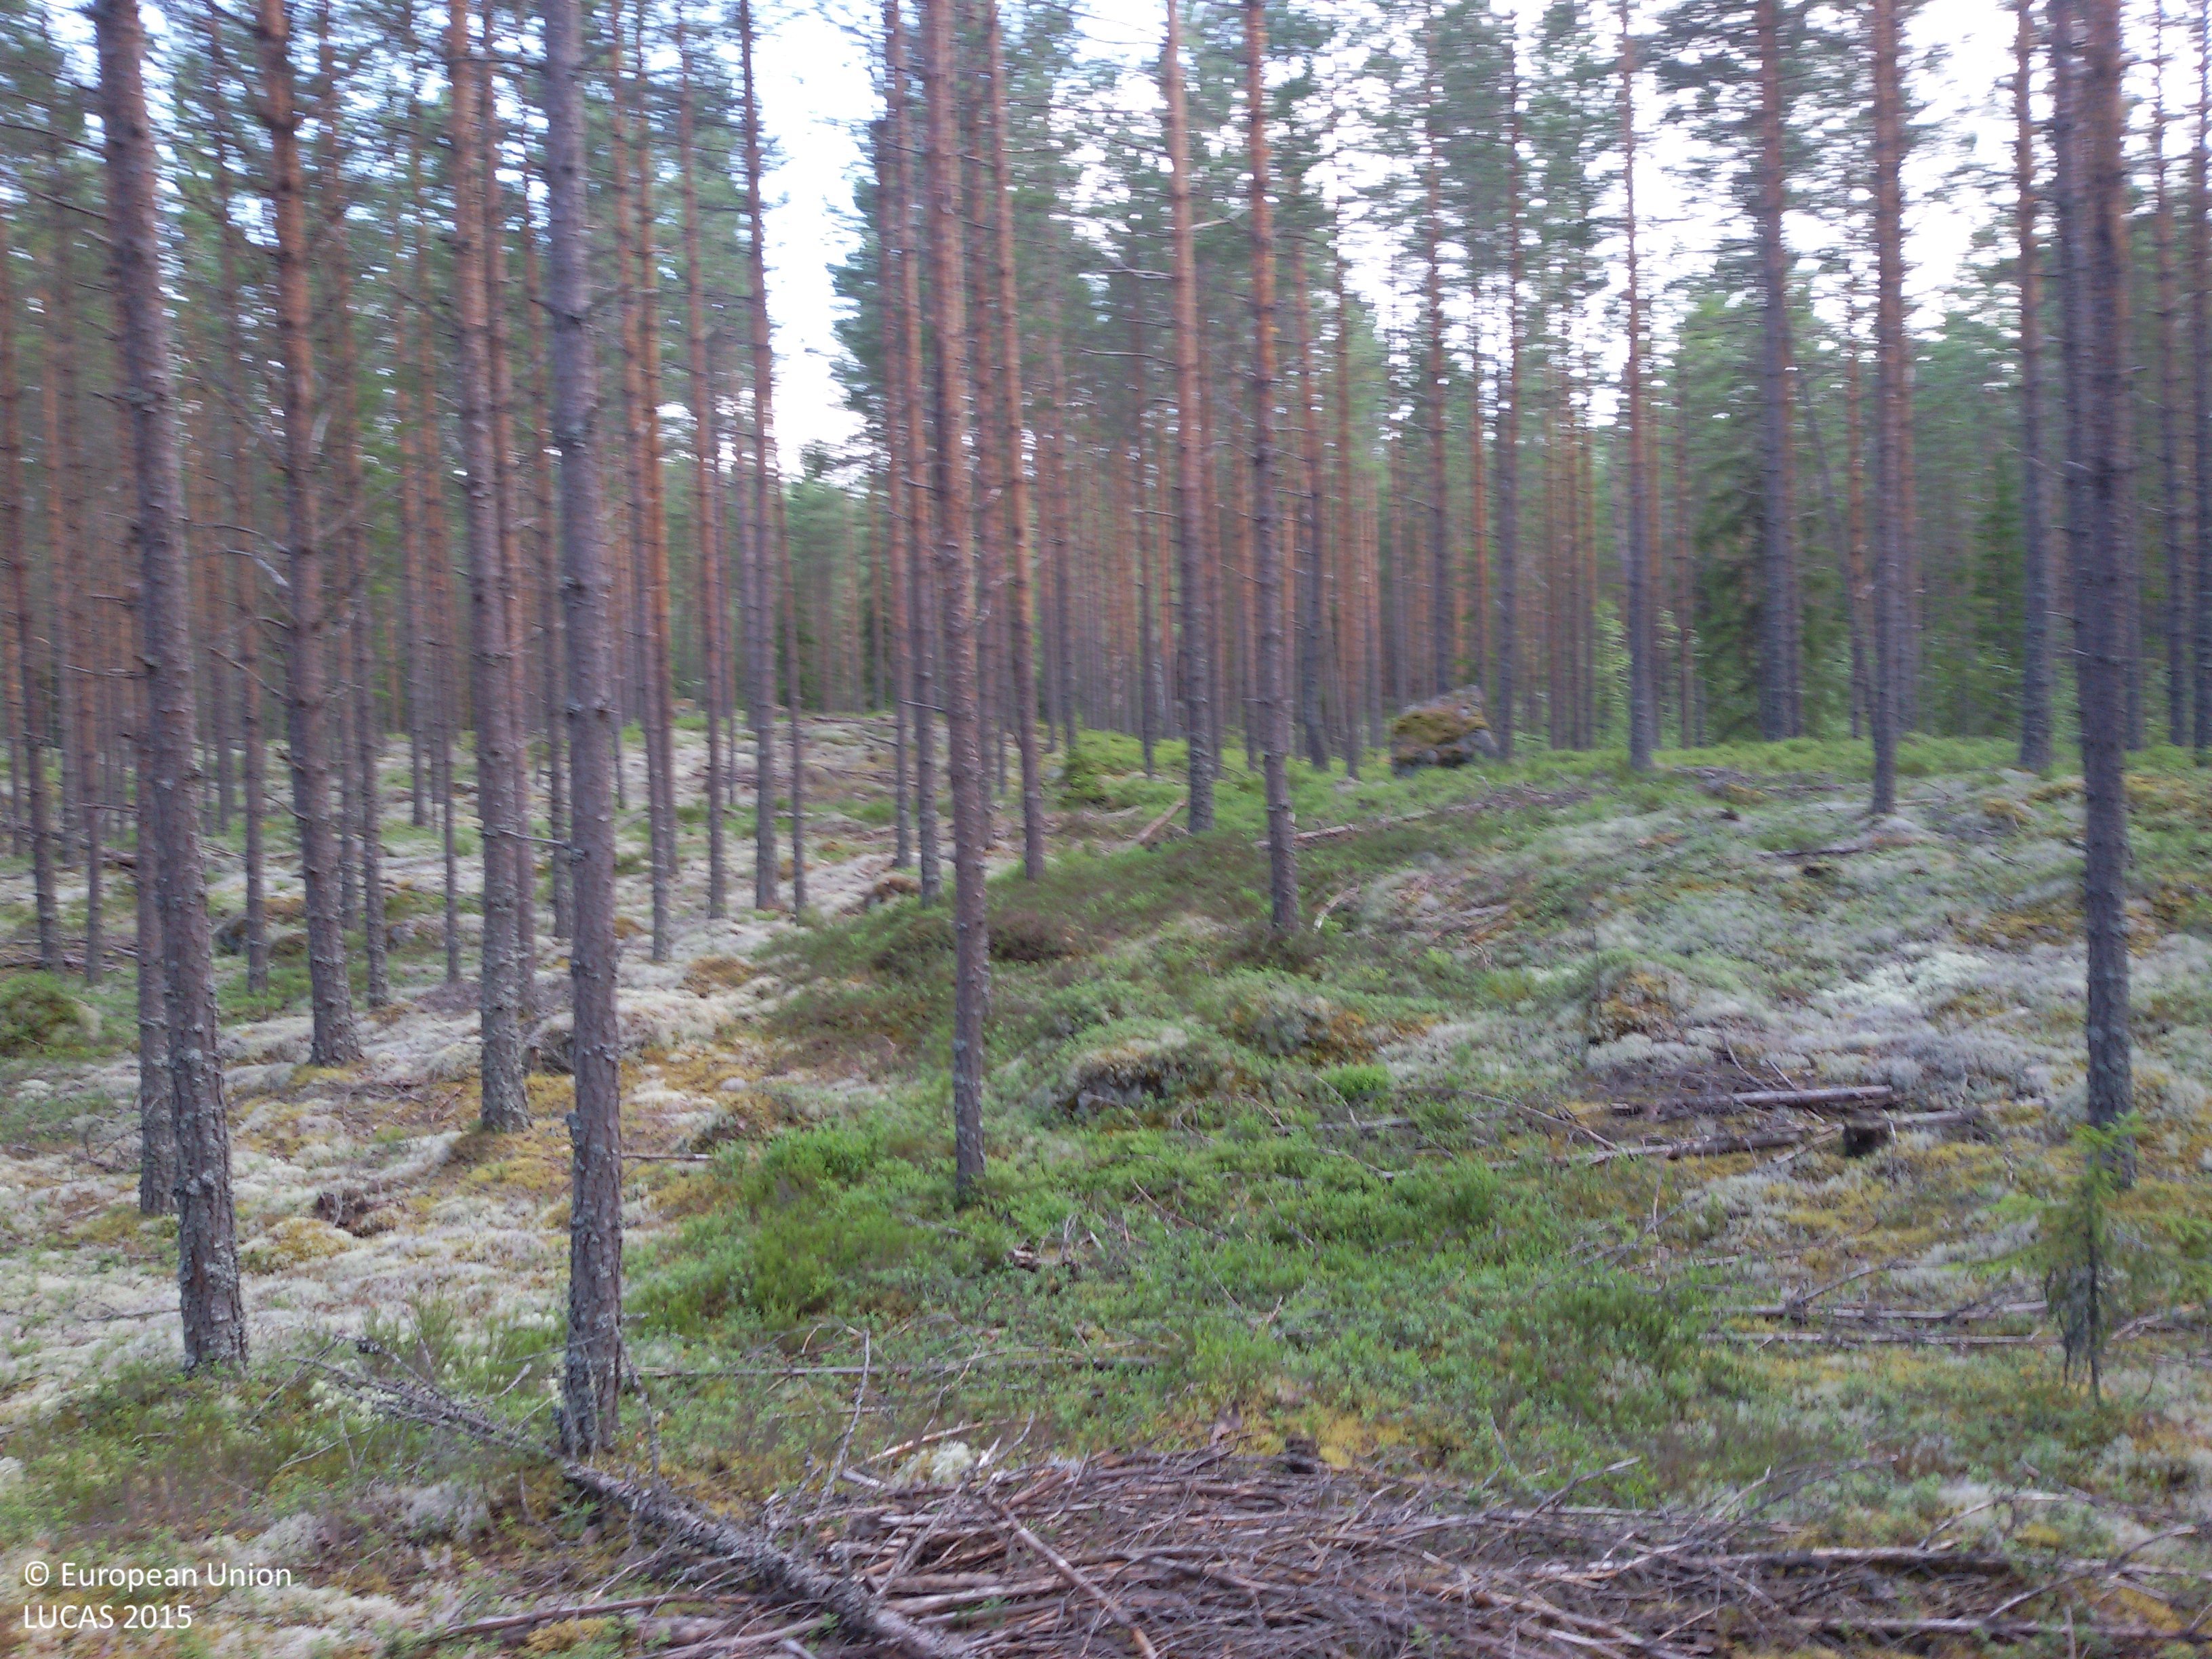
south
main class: Woodland
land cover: Pine dominated coniferous woodland
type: boreal forest
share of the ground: 50 - 75 %
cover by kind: coniferous forest trees 70 %, herbaceous plants 15 %, lichens and mosses 15 %
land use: Forestry
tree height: > 5 m
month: July
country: SE
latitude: 60.3482
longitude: 14.8991
